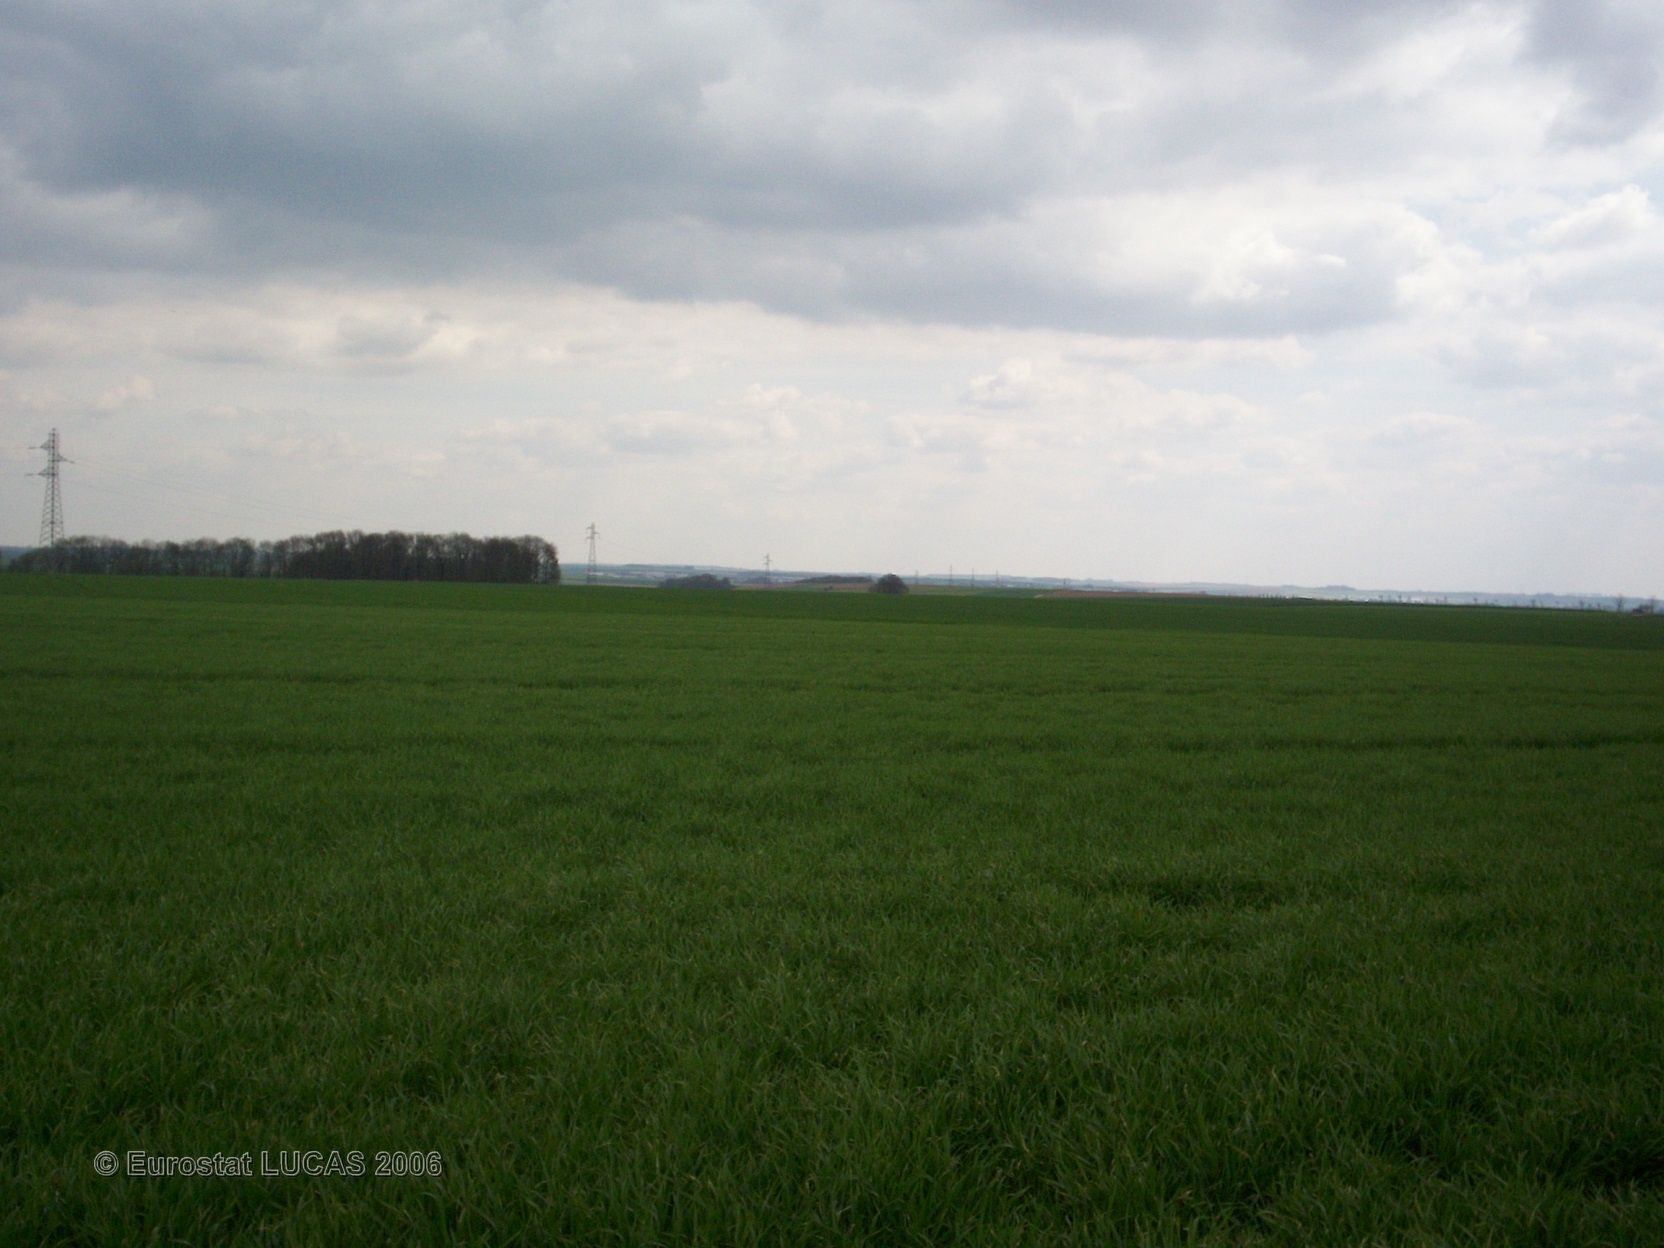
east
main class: Cropland
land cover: Common wheat
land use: Agriculture (excluding fallow land and kitchen gardens)
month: April
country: FR
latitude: 50.0144
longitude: 2.5778
